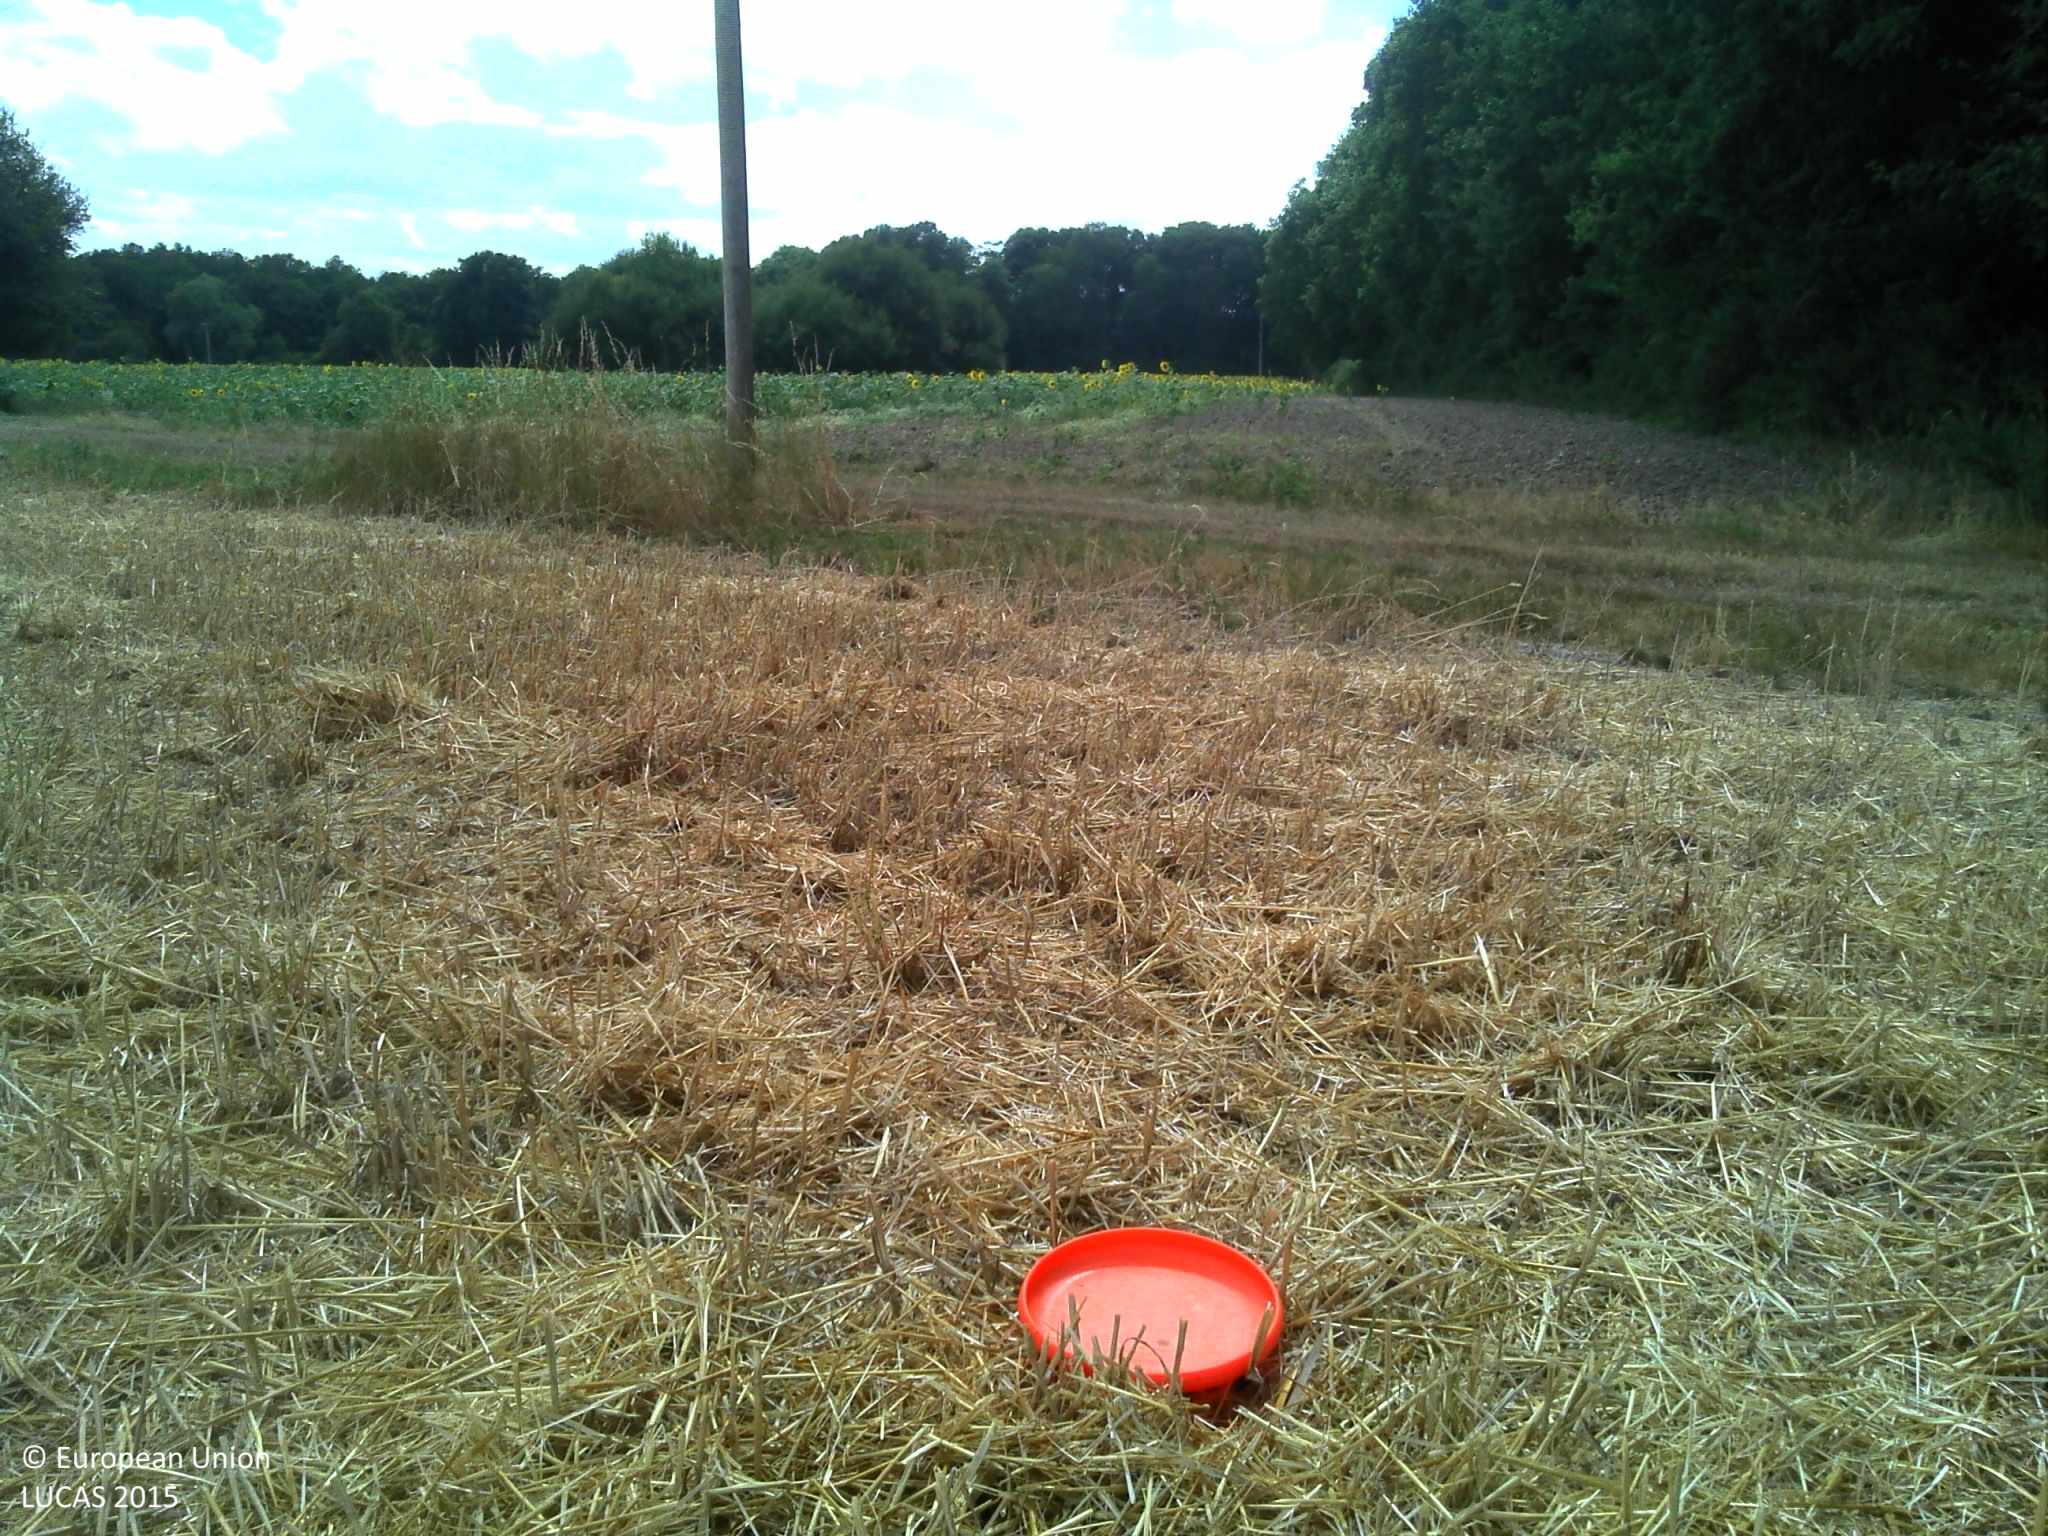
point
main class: Cropland
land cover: Common wheat
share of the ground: > 75 %
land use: Agriculture (excluding fallow land and kitchen gardens)
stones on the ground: < 10 %
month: July
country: FR
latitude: 47.1156
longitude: 0.8229
